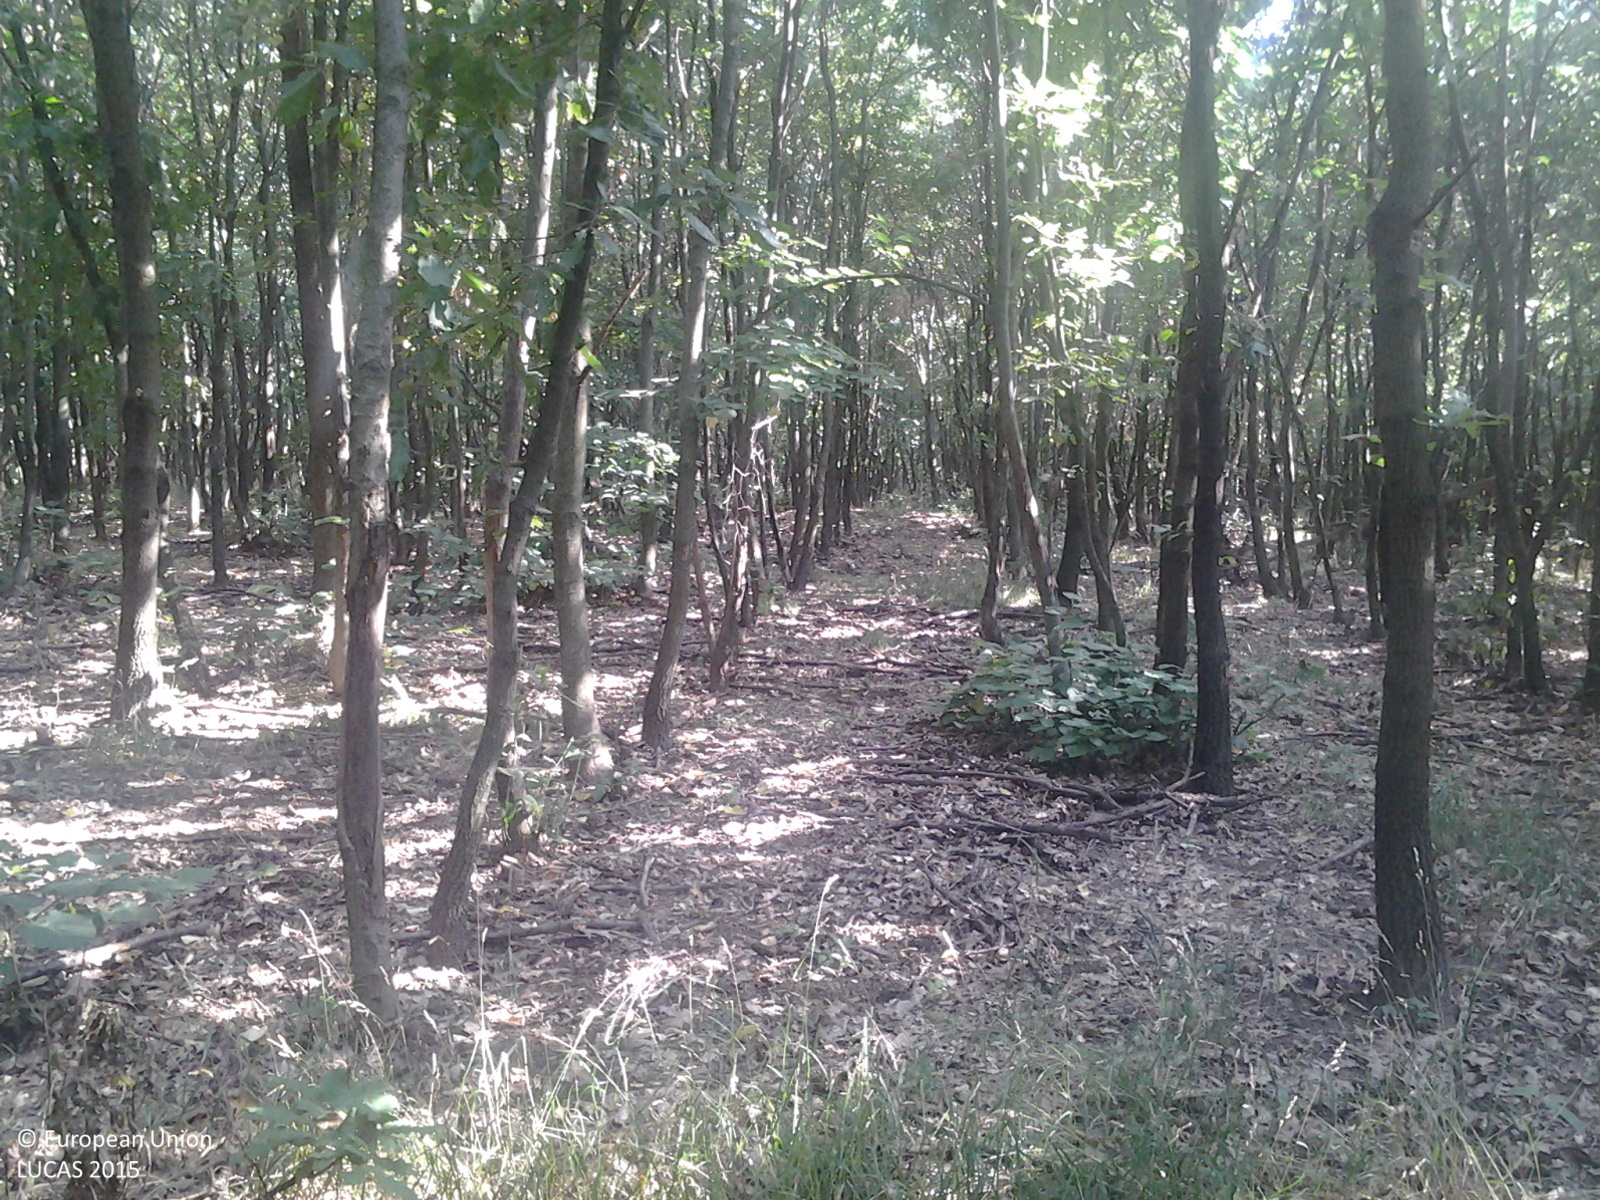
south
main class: Woodland
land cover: Broadleaved woodland
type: mesophytic deciduous forest
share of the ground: > 75 %
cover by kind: broadleaved forest trees 90 %, herbaceous plants 10 %
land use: Forestry
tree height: > 5 m
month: July
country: HU
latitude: 46.4563
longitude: 18.3812
